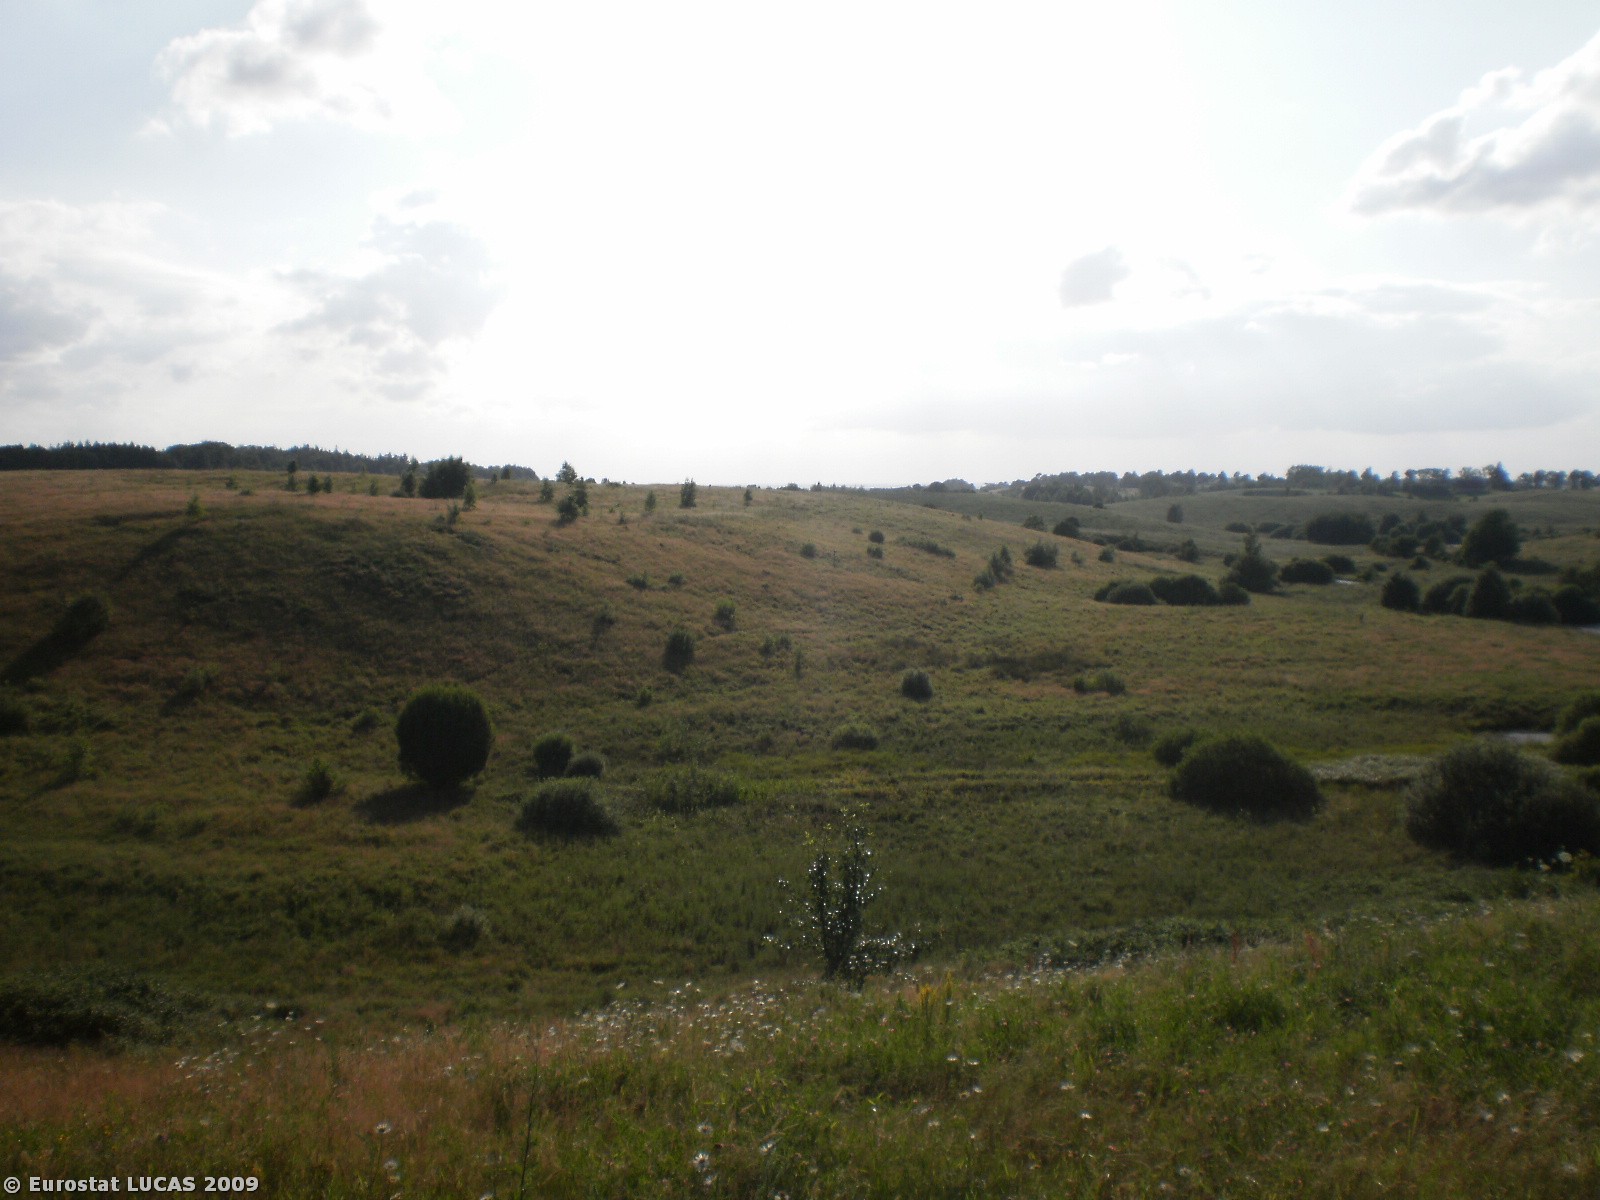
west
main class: Grassland
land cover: Grassland with sparse tree/shrub cover
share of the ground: > 75 %
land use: Unused
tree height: > 5 m
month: July
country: PL
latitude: 53.9691
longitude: 20.6021
